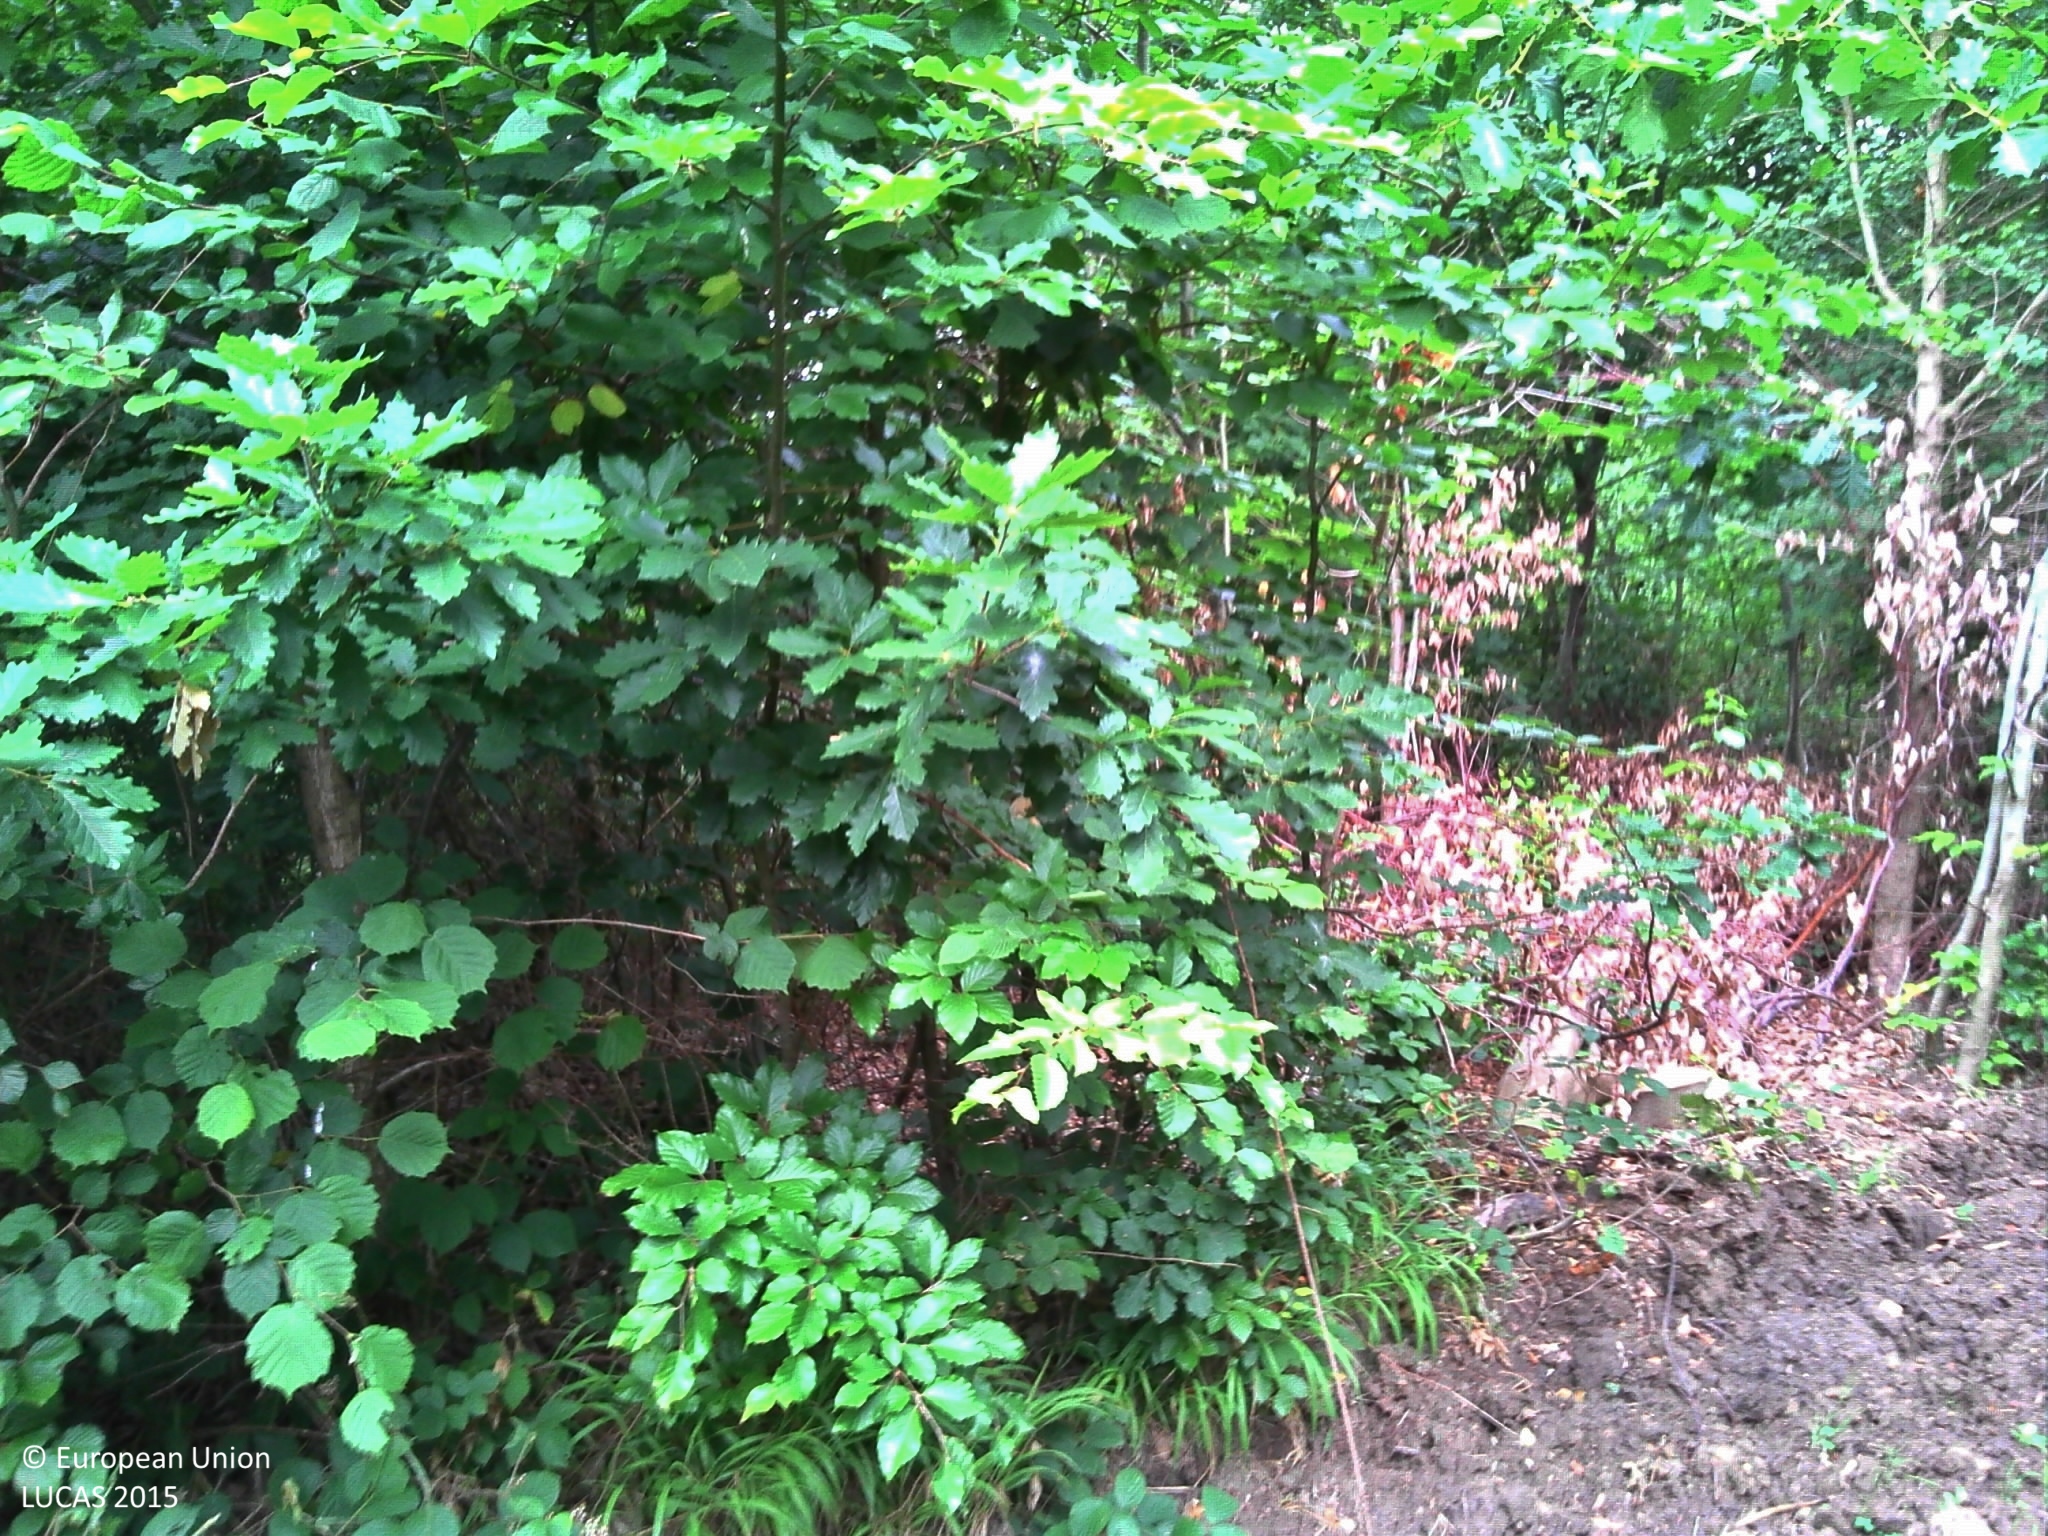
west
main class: Woodland
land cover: Broadleaved woodland
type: acidophilous oak and oak-birch forest
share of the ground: > 75 %
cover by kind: broadleaved forest trees 80 %, shrubs 15 %, herbaceous plants 5 %
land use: Forestry
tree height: > 5 m
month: July
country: FR
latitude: 49.2365
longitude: 2.5584
